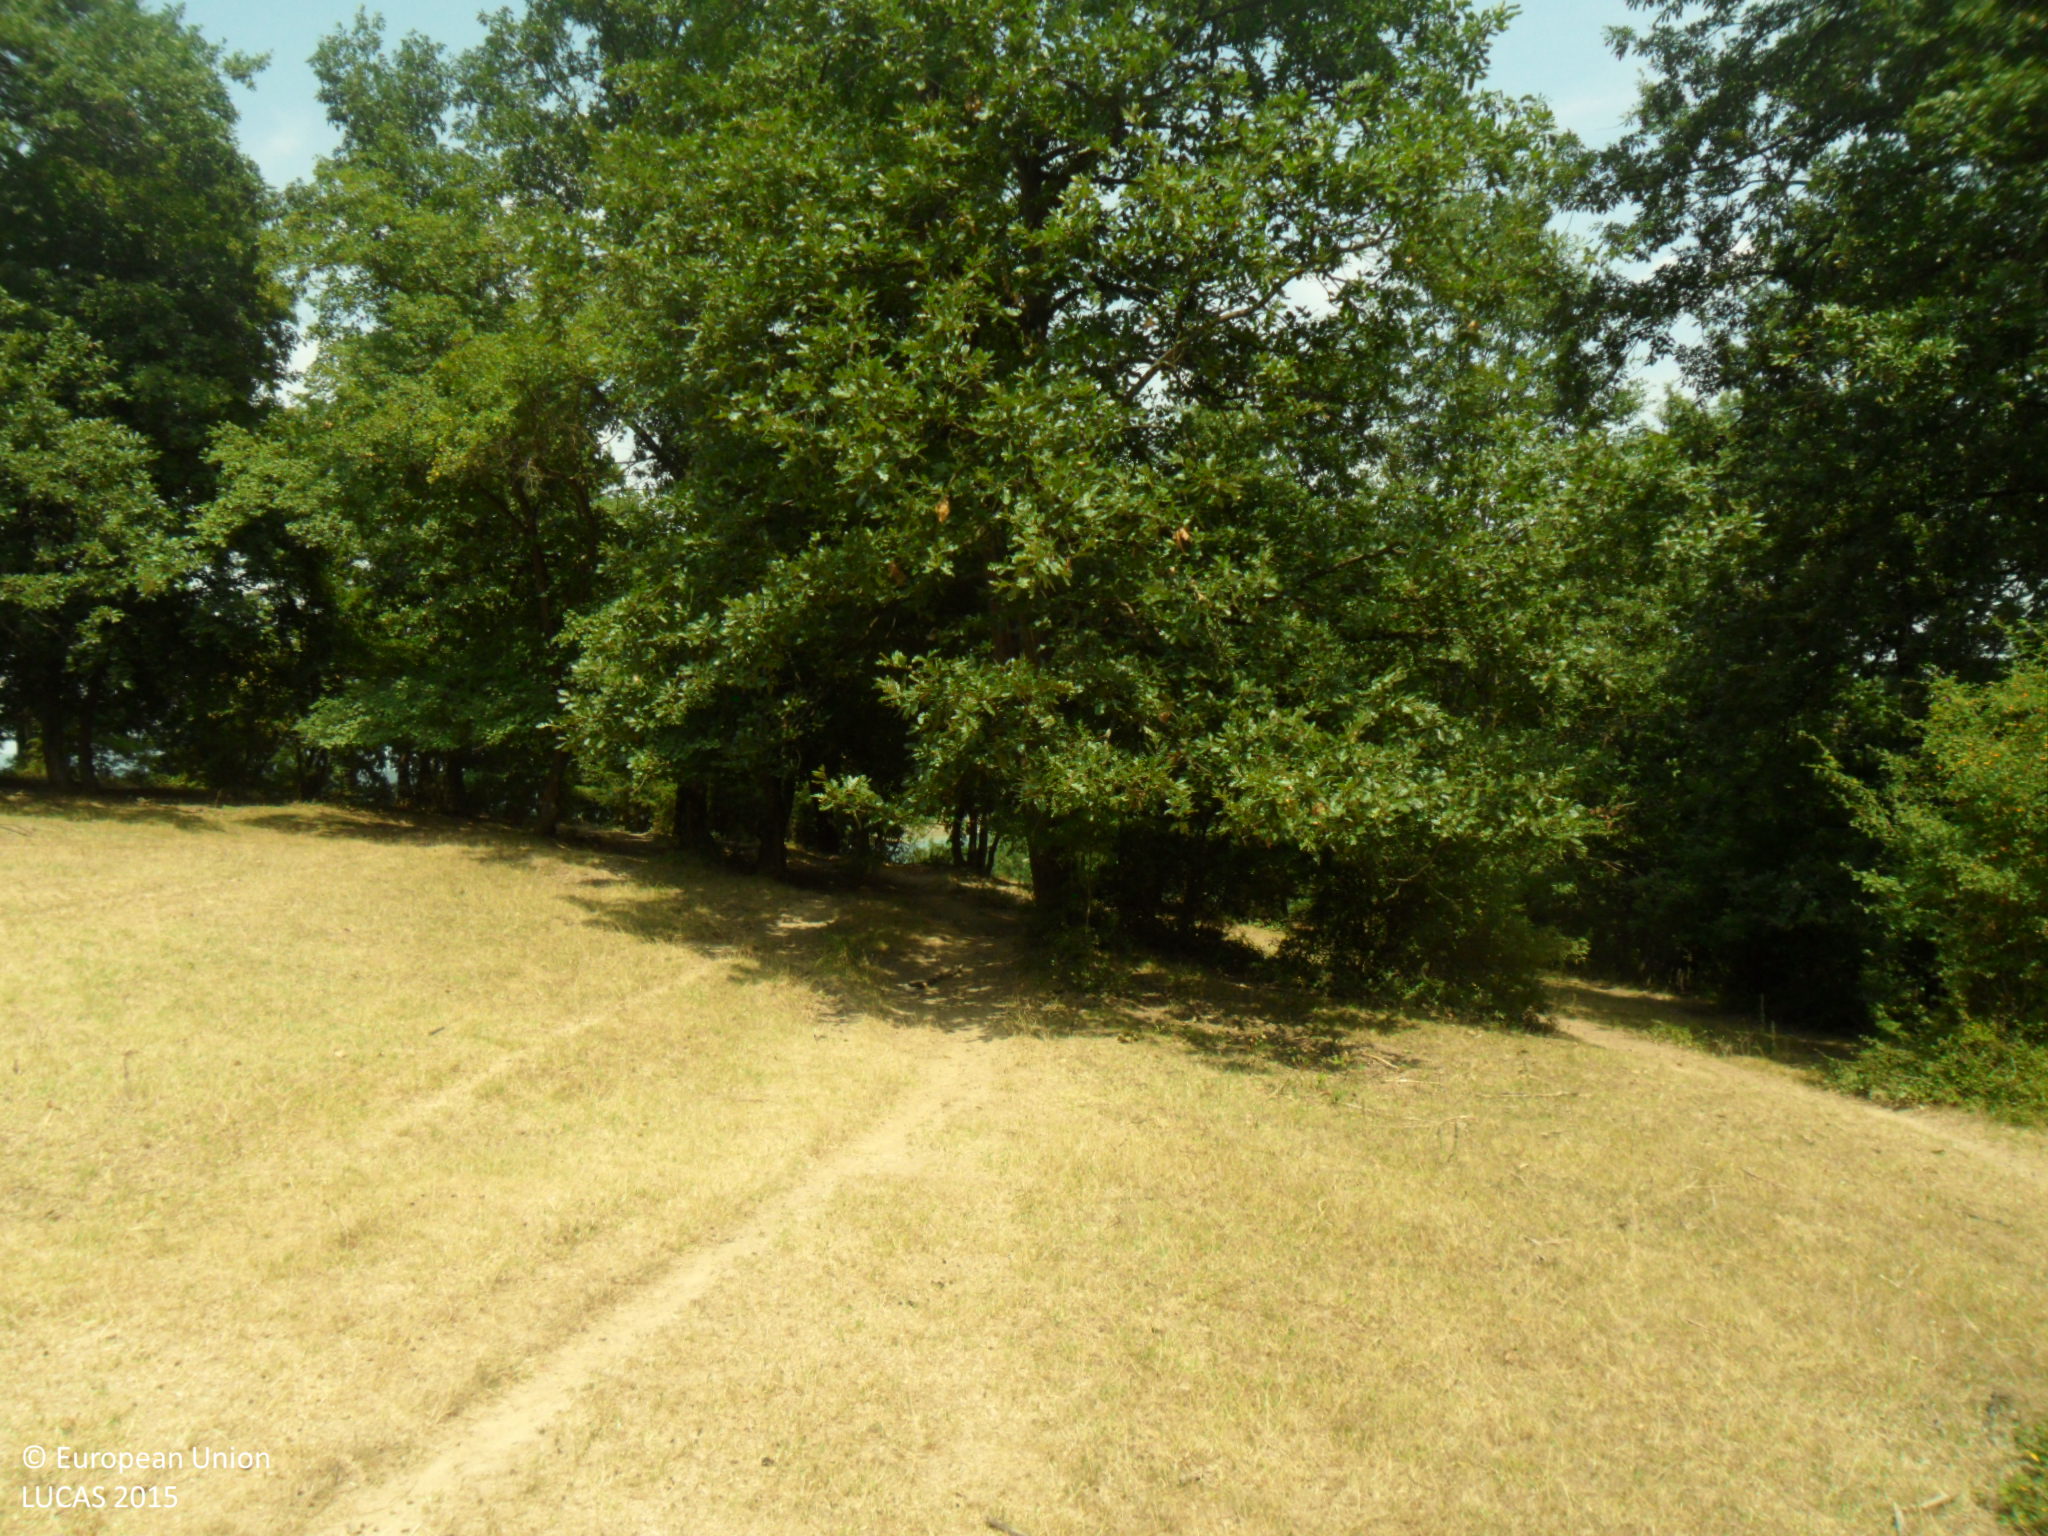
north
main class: Grassland
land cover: Grassland without tree/shrub cover
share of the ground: > 75 %
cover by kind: herbaceous plants 100 %
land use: Agriculture (excluding fallow land and kitchen gardens)
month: August
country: BG
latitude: 43.0348
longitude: 26.7357
